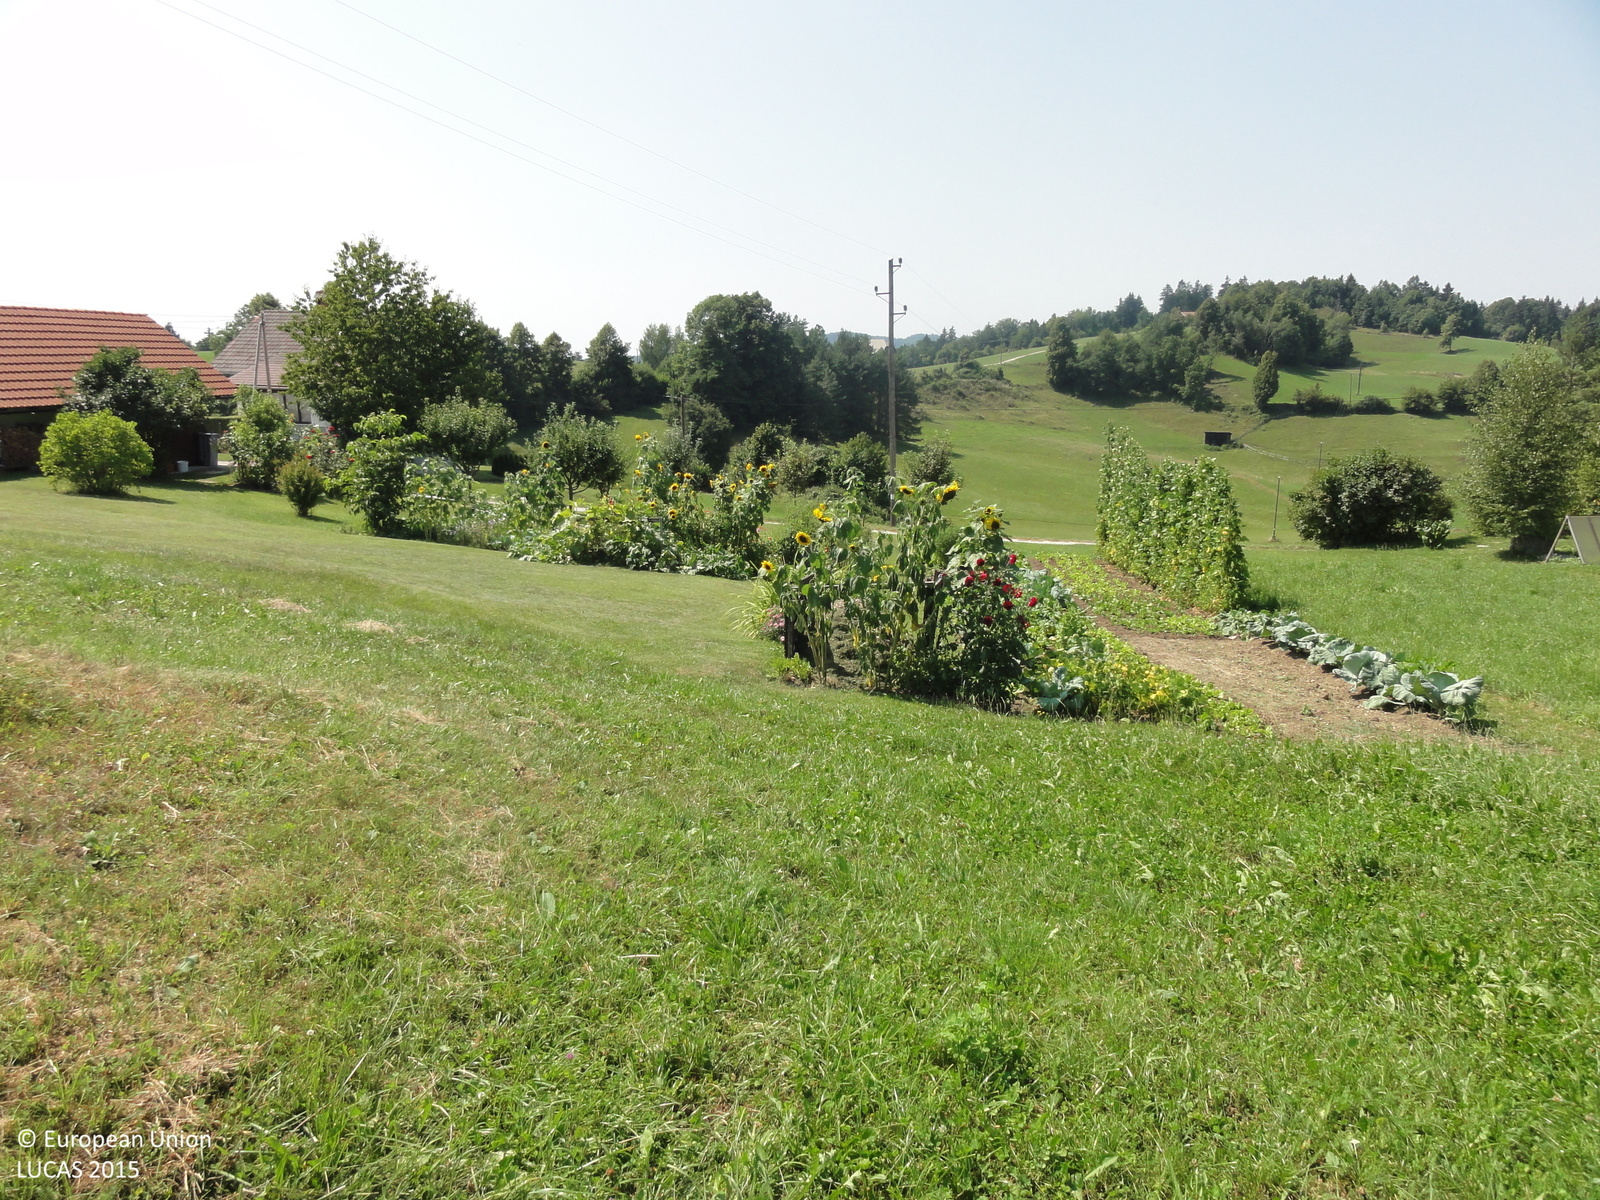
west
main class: Grassland
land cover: Grassland without tree/shrub cover
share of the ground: > 75 %
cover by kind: herbaceous plants 100 %
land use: Agriculture (excluding fallow land and kitchen gardens)
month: August
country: SI
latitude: 46.0347
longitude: 15.0230
